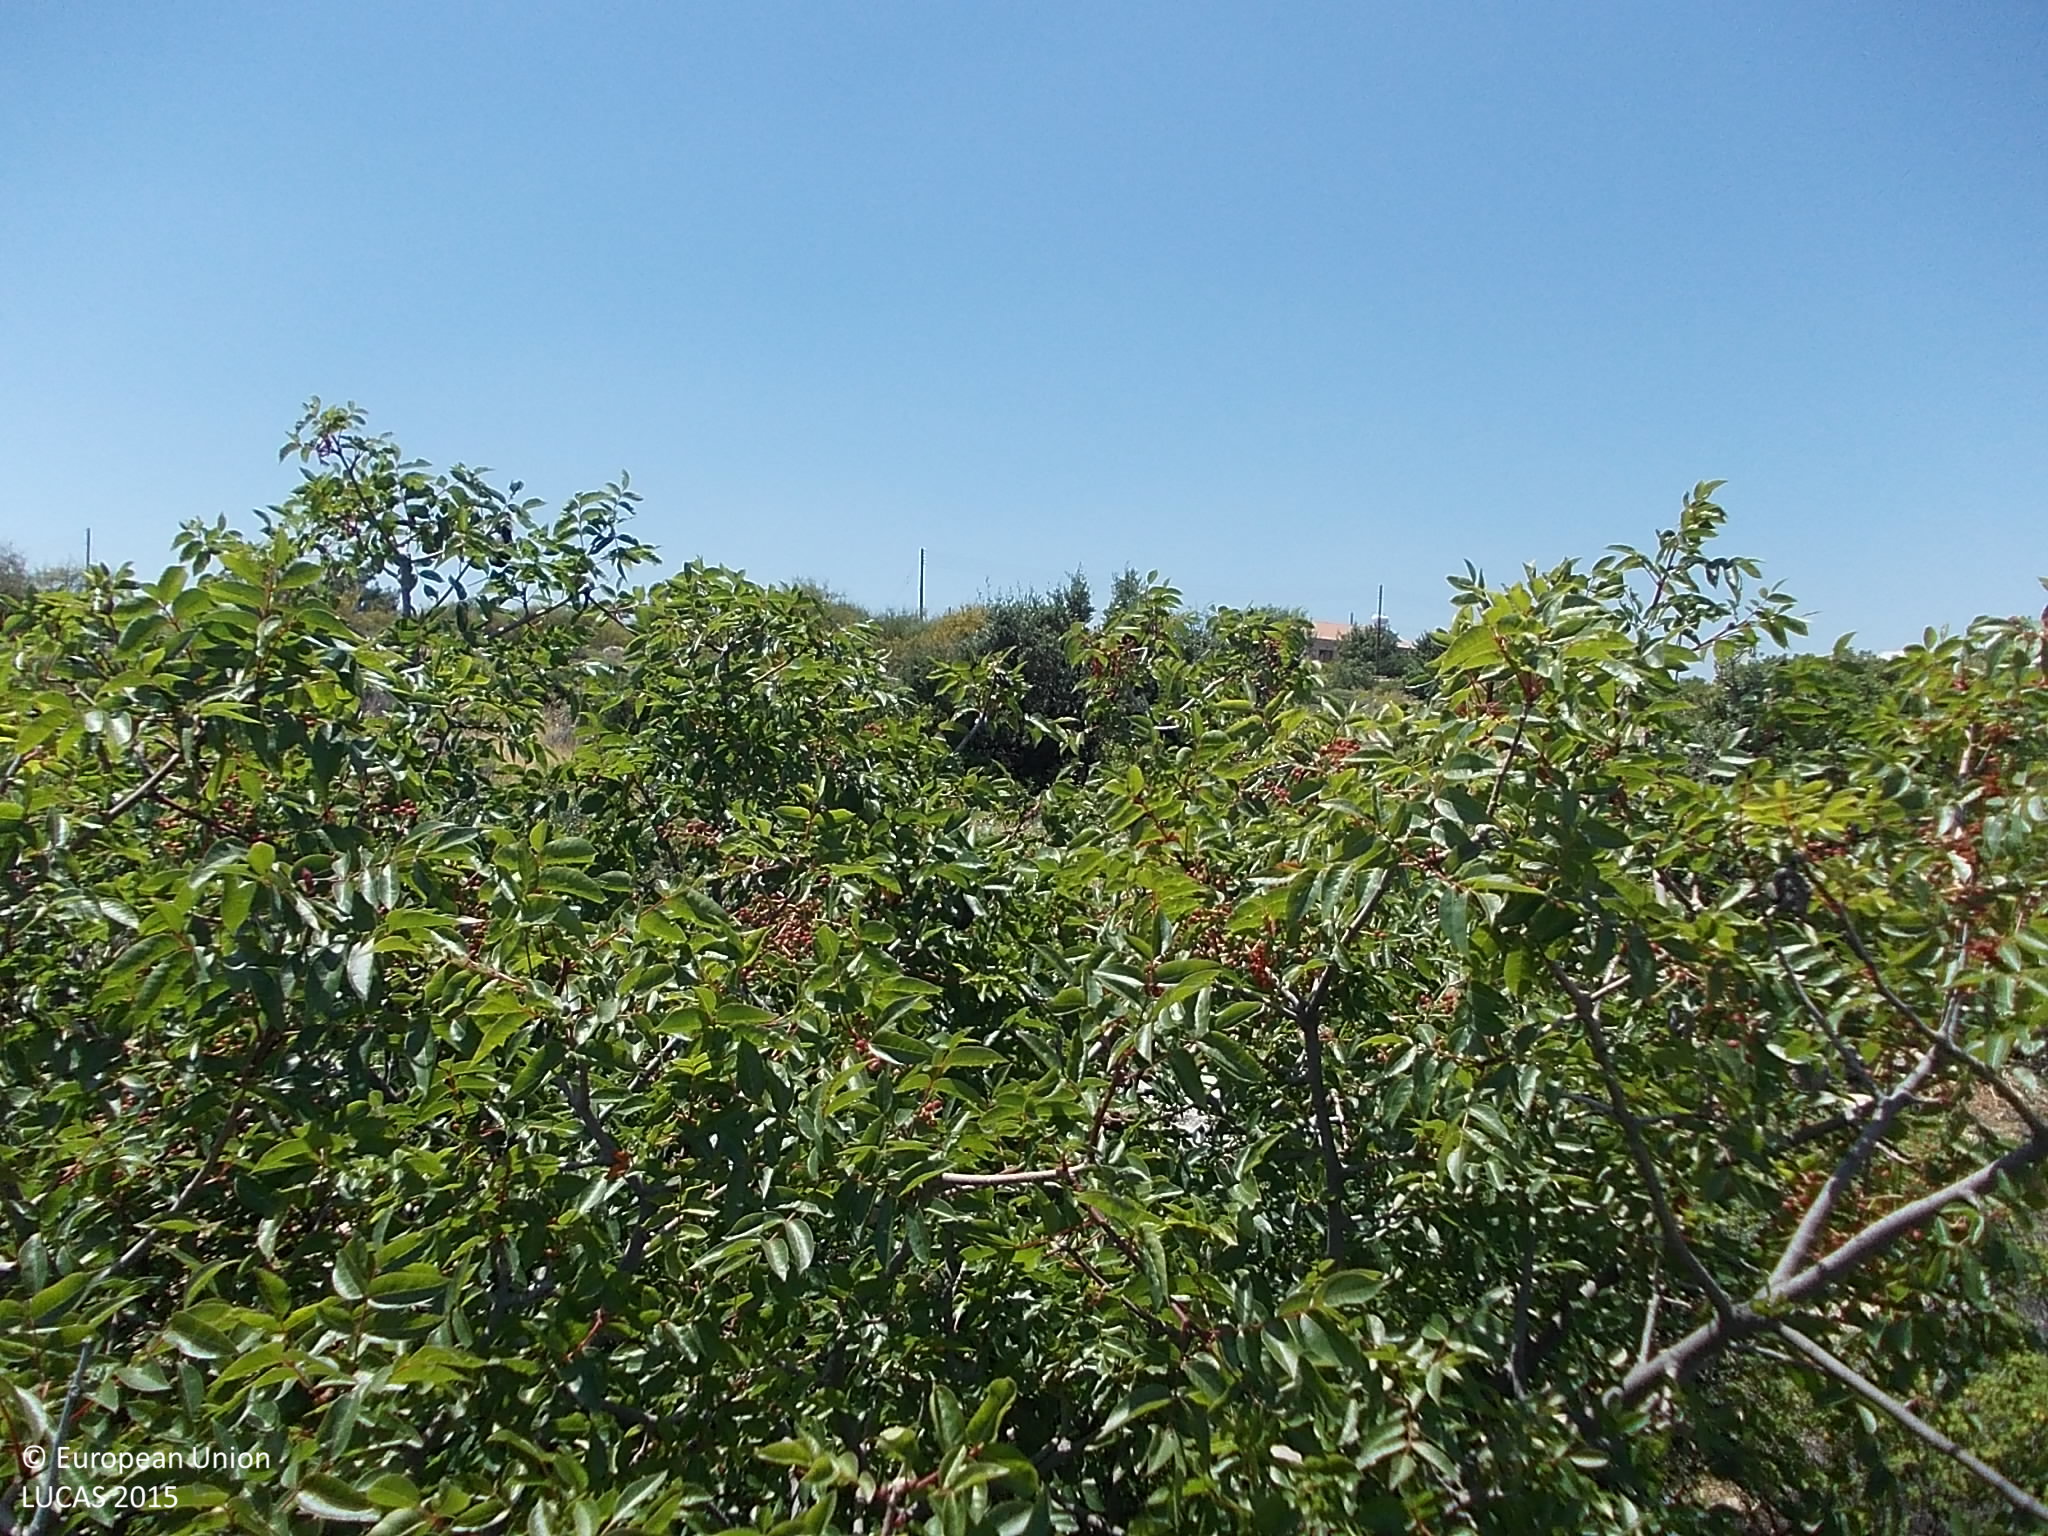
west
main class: Shrubland
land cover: Shrubland without tree cover
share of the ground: 50 - 75 %
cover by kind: shrubs 65 %, herbaceous plants 20 %, unconsolidated bare surface 10 %, consolidated bare surface 5 %
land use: Semi-natural and natural areas not in use
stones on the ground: 10 - 25 %
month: June
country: CY
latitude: 34.7291
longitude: 32.8868
